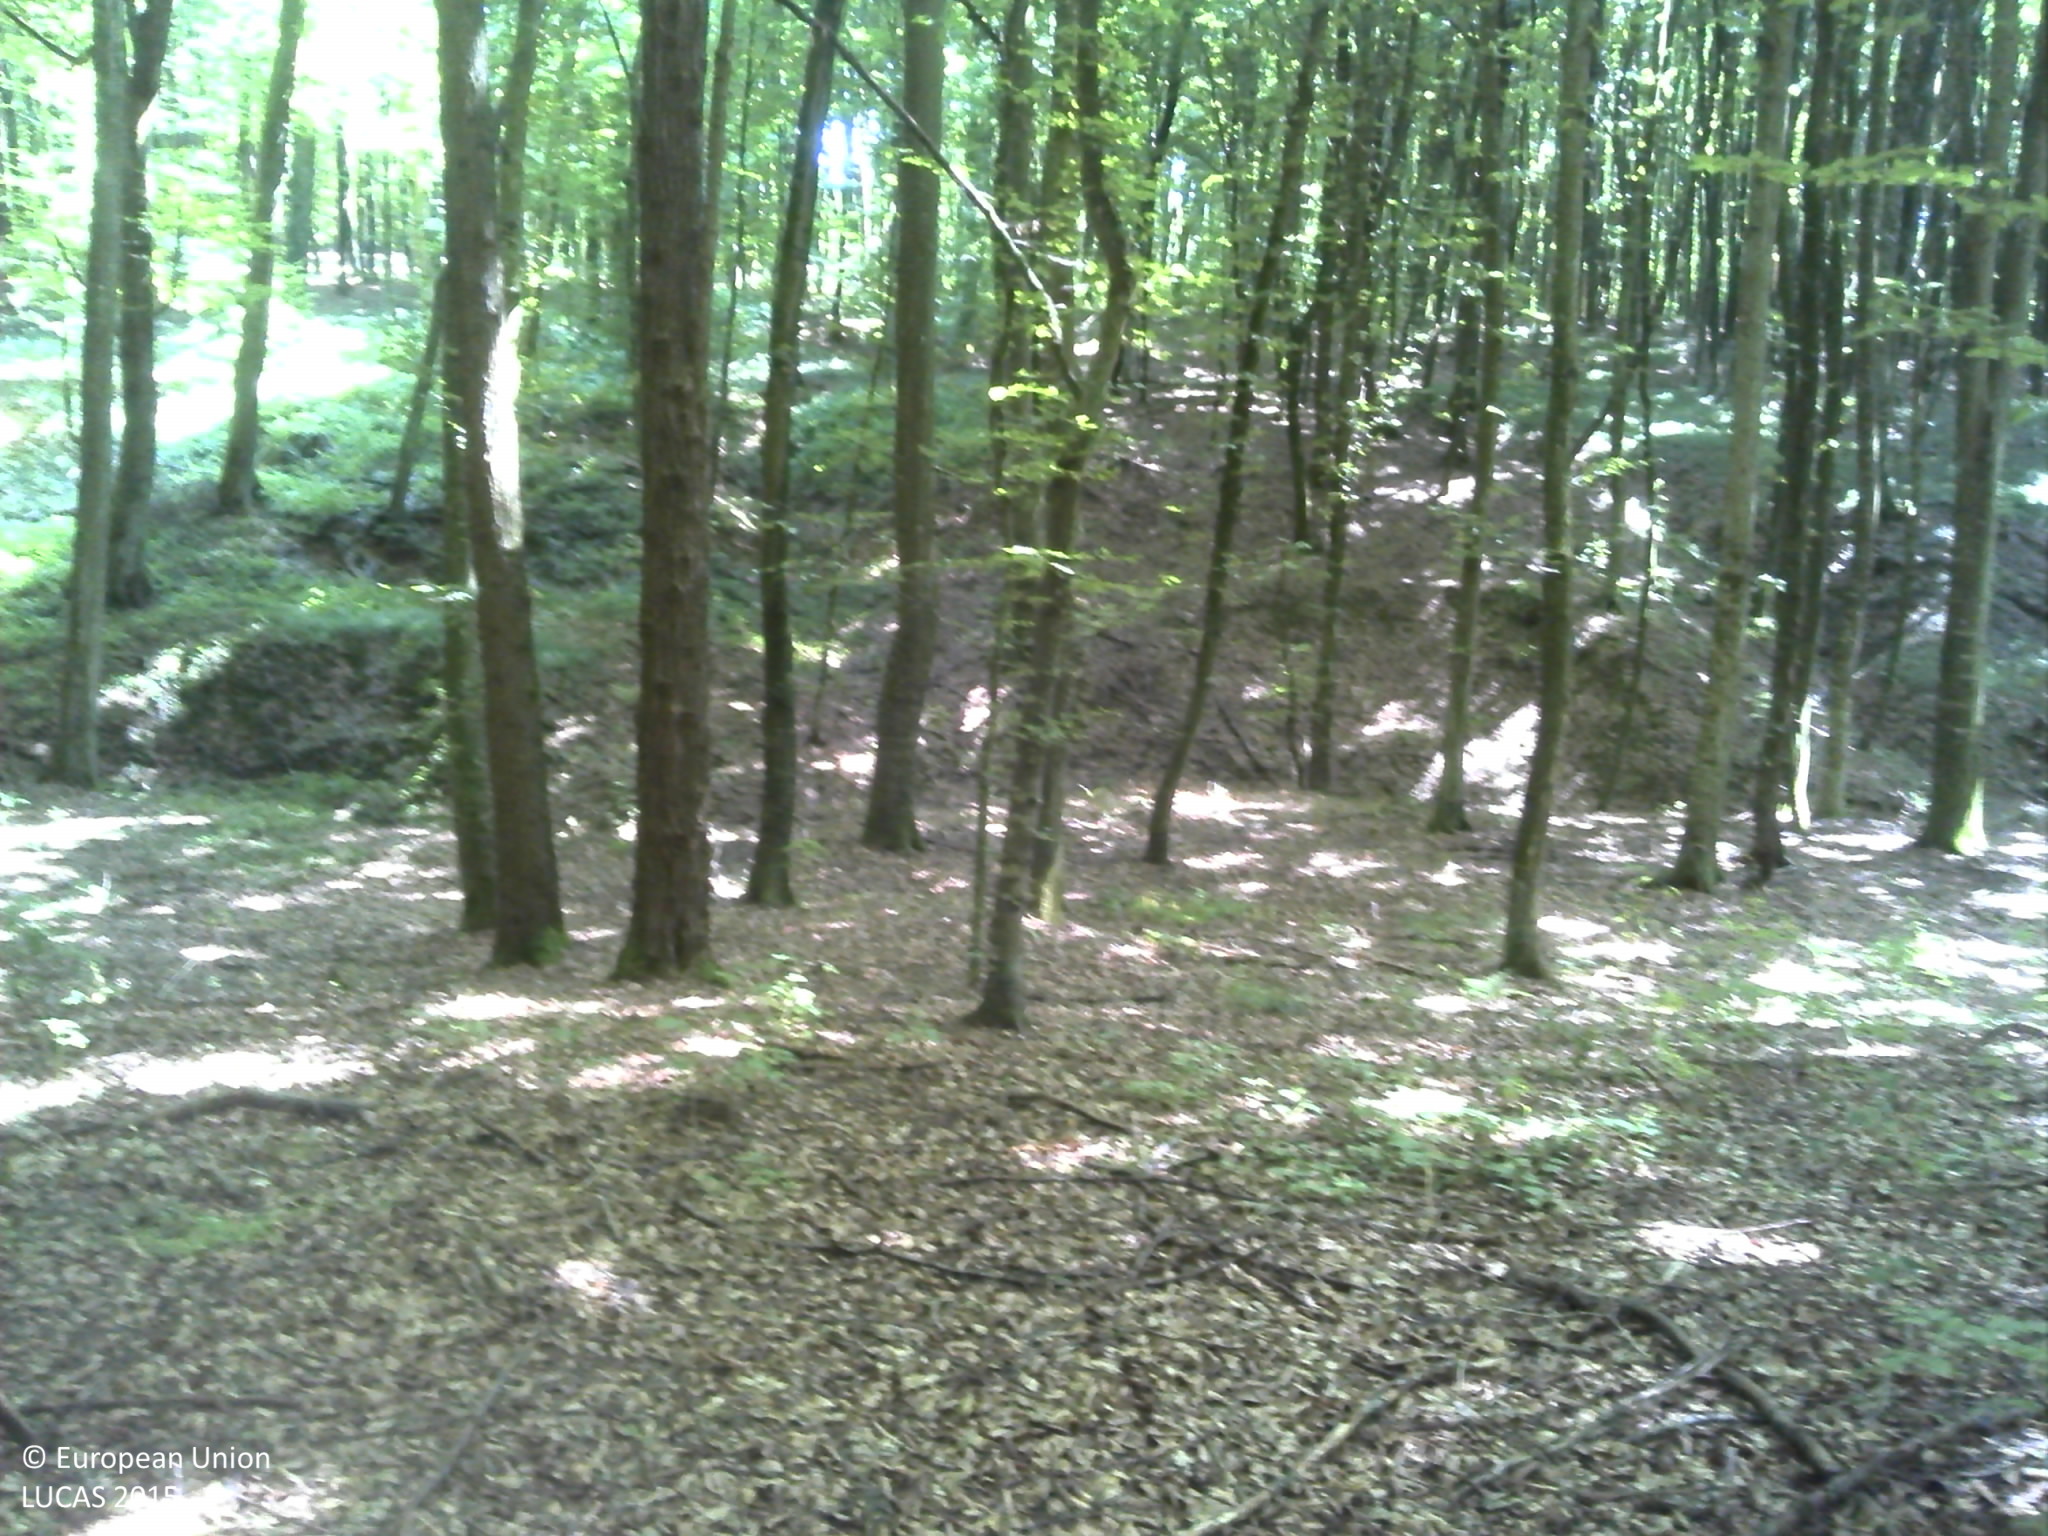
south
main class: Woodland
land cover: Broadleaved woodland
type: acidophilous oak and oak-birch forest
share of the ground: > 75 %
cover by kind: broadleaved forest trees 90 %, shrubs 5 %, herbaceous plants 5 %
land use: Forestry
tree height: > 5 m
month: July
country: HR
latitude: 45.5505
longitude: 17.1607
